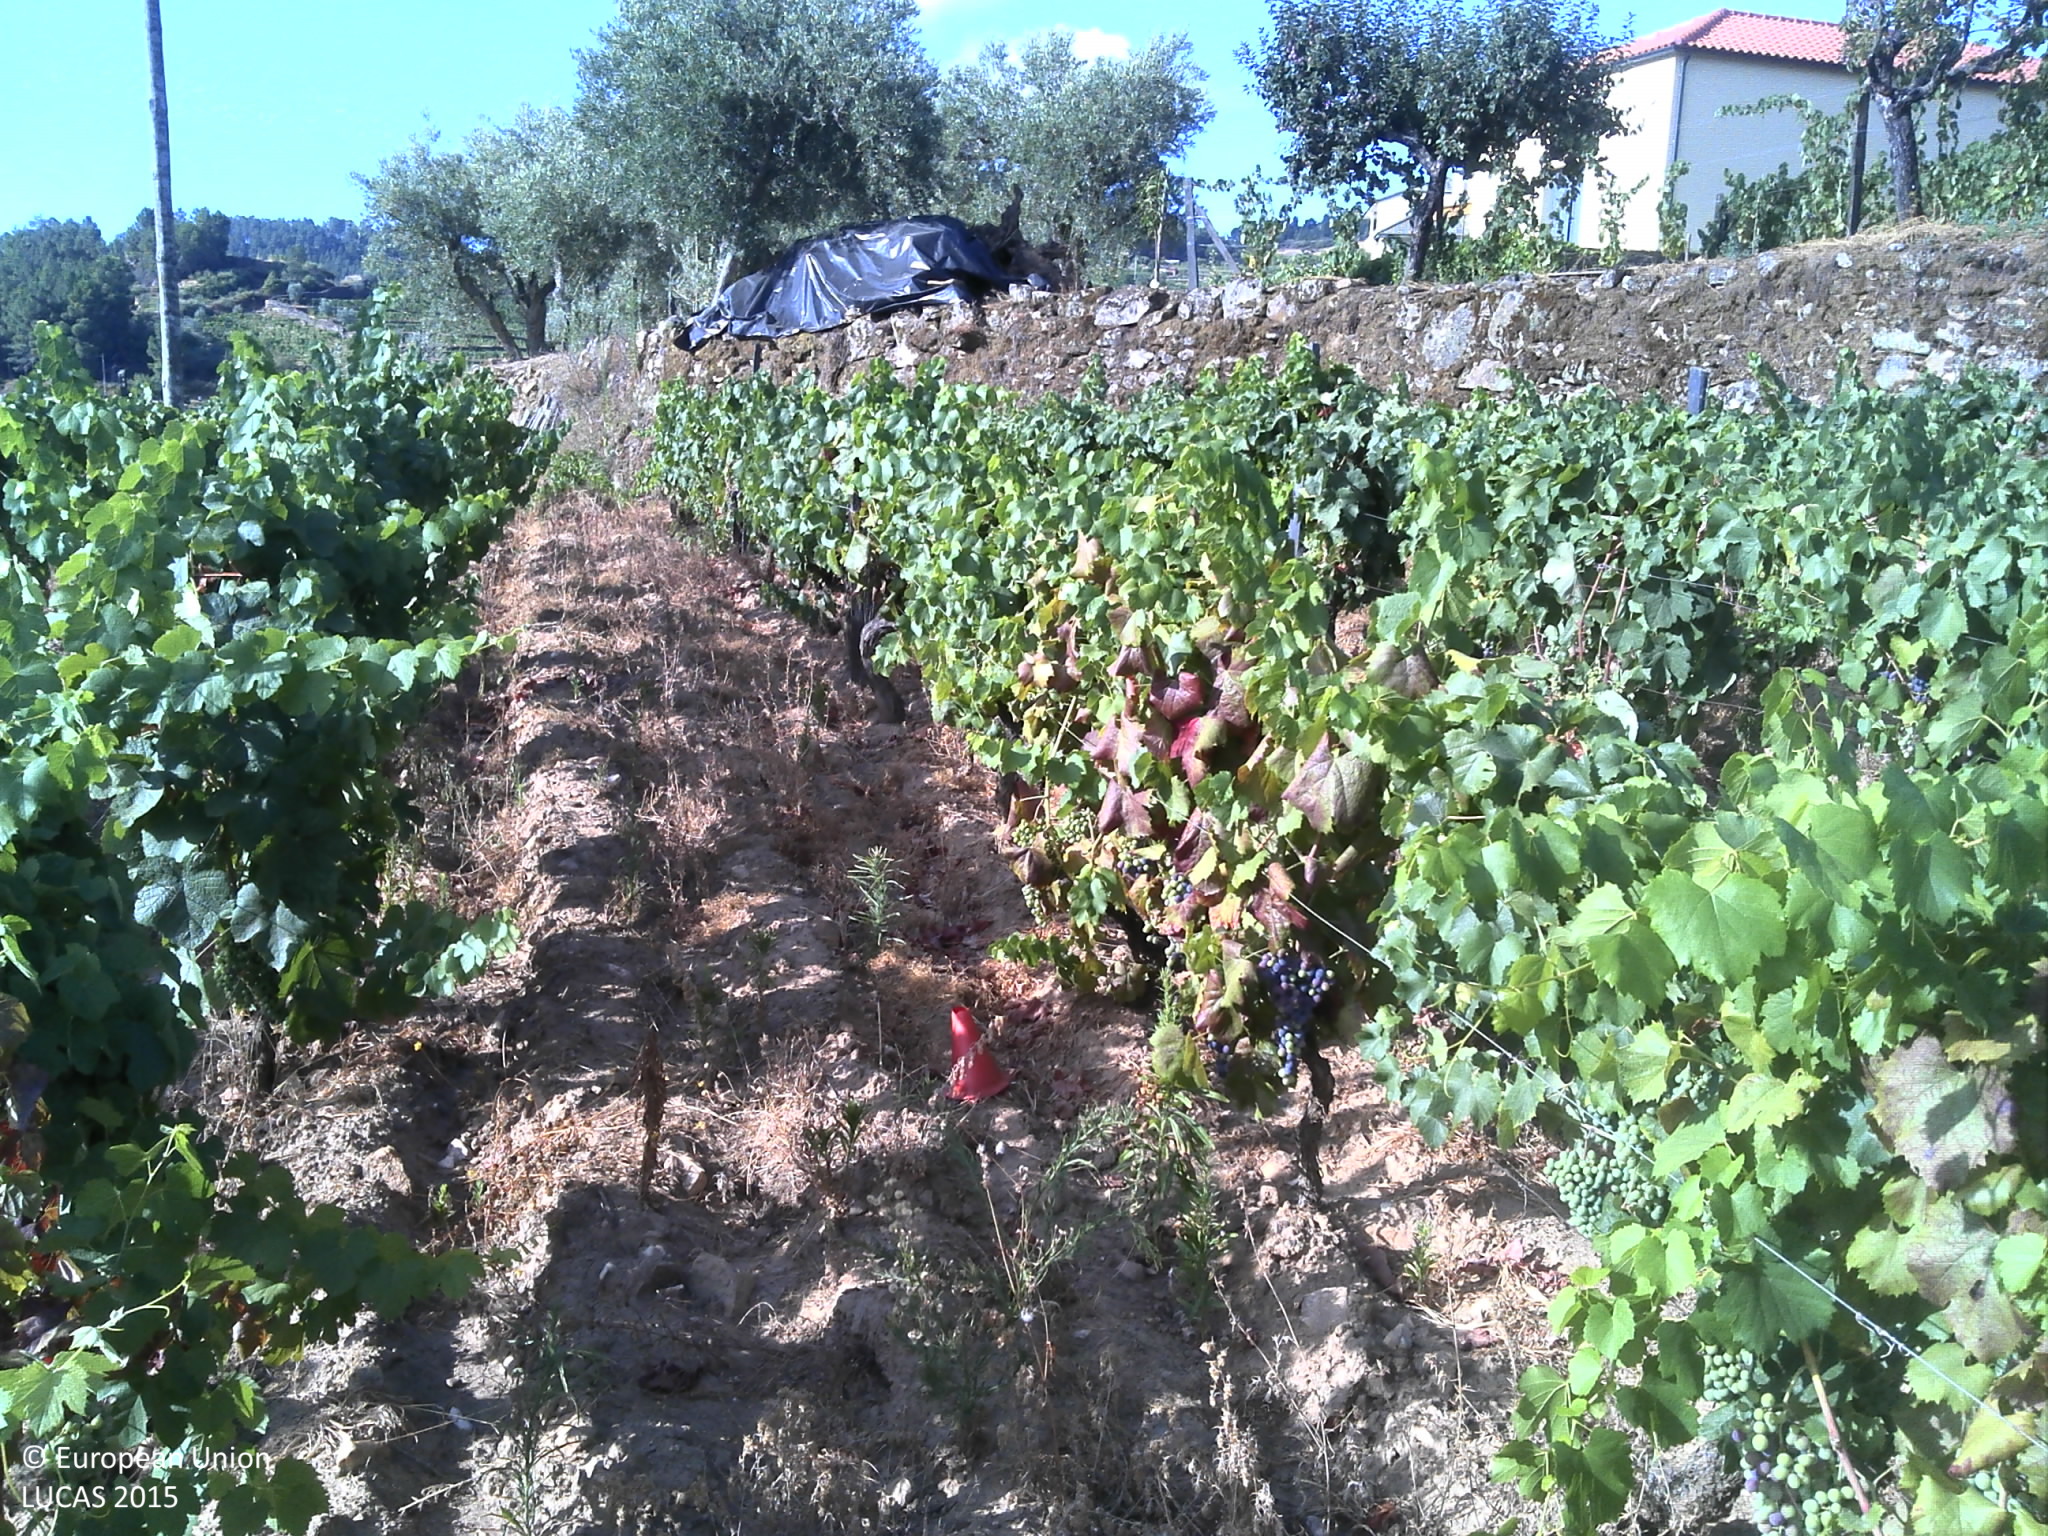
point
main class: Cropland
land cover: Vineyards
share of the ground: < 10 %
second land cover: Grassland without tree/shrub cover
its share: 50 - 75 %
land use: Agriculture (excluding fallow land and kitchen gardens)
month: July
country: PT
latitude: 41.2563
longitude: -7.4393
